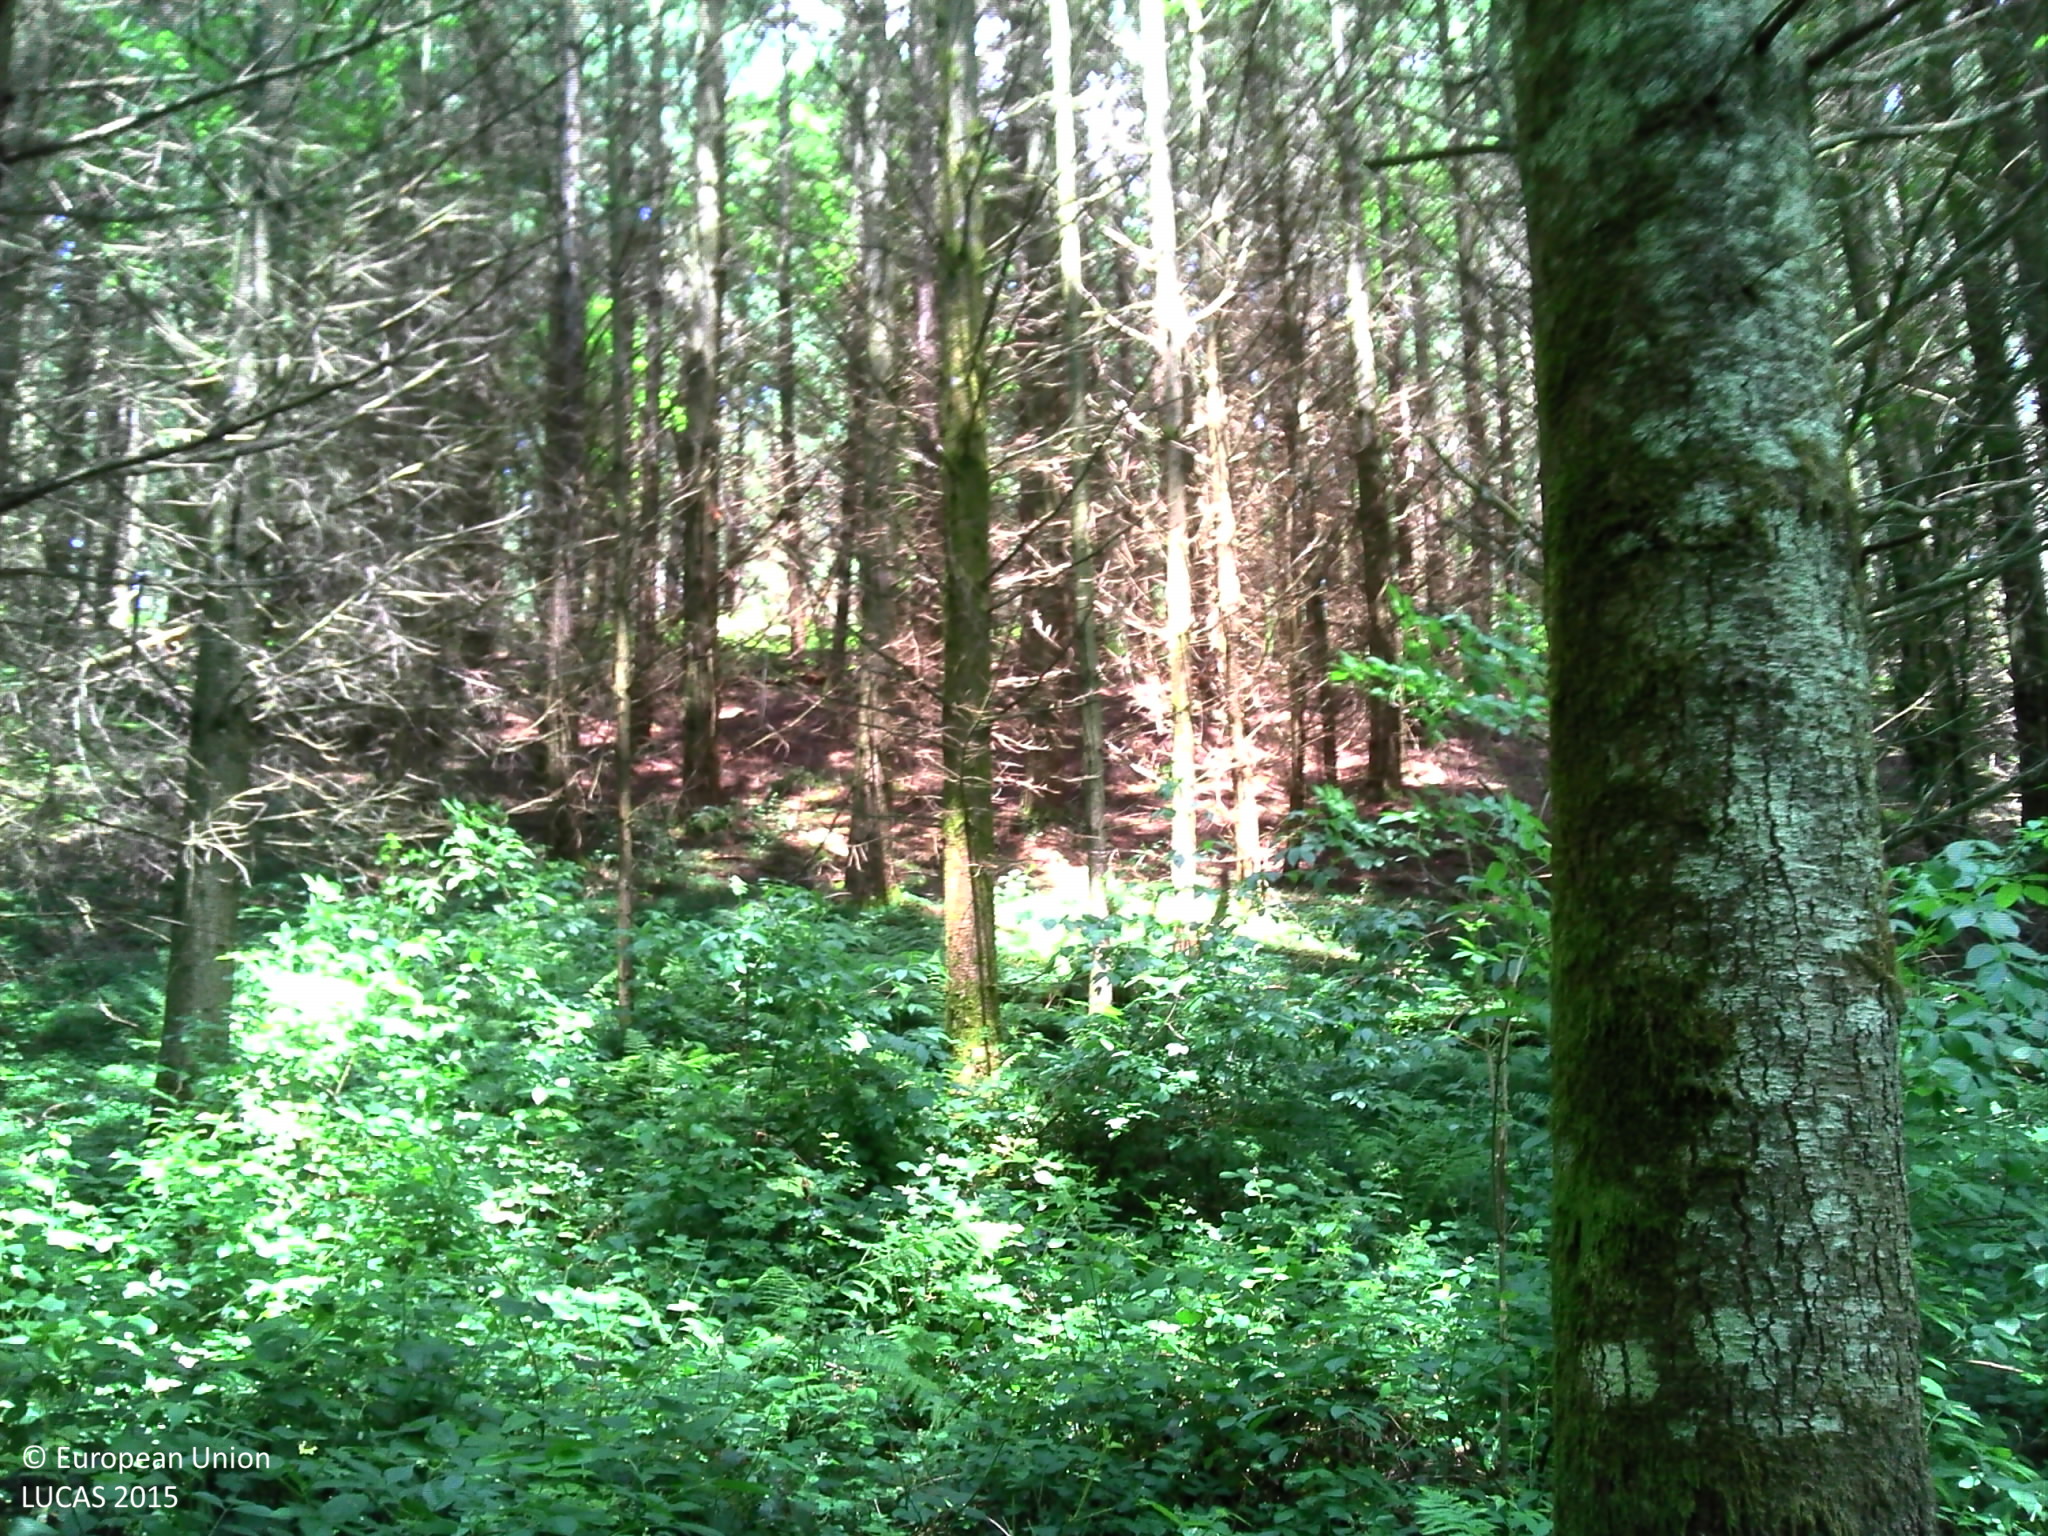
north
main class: Woodland
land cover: Pine dominated mixed woodland
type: acidophilous oak and oak-birch forest
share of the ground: > 75 %
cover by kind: broadleaved forest trees 70 %, coniferous forest trees 25 %, herbaceous plants 5 %
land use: Forestry
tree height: > 5 m
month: June
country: FR
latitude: 46.1591
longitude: 3.0184
